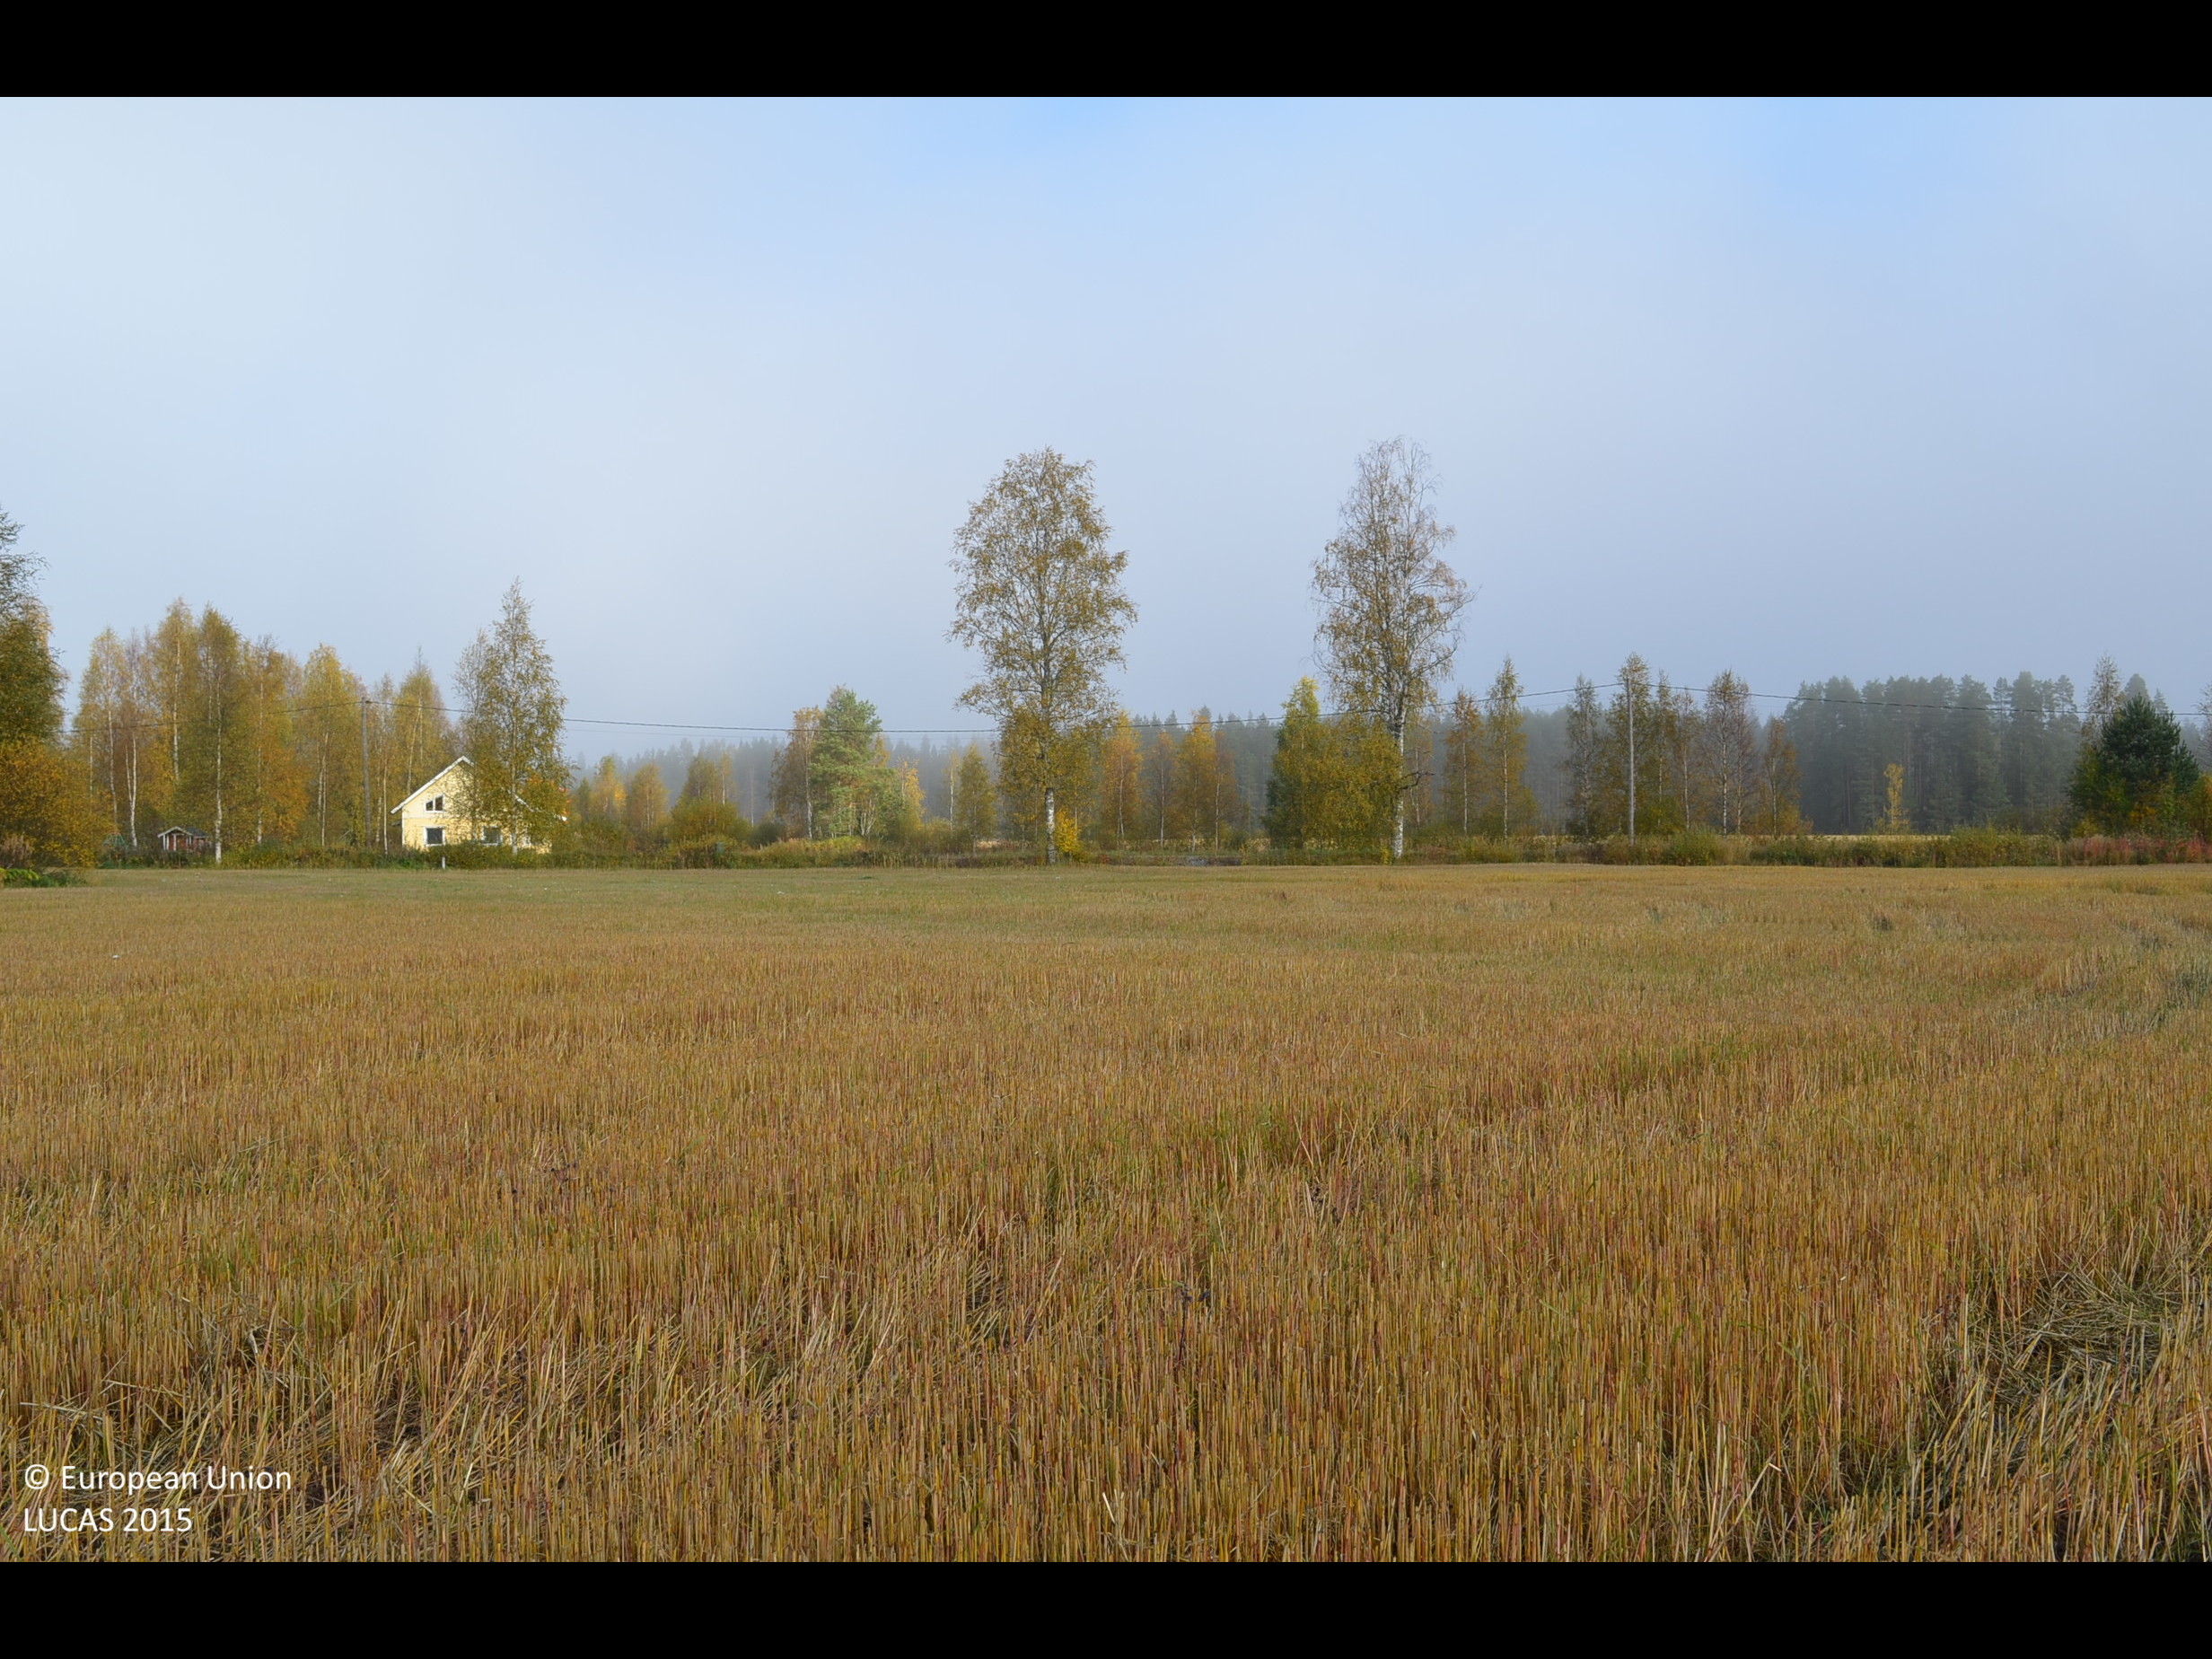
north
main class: Cropland
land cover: Oats
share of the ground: > 75 %
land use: Agriculture (excluding fallow land and kitchen gardens)
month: September
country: FI
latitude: 62.5998
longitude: 23.5694
